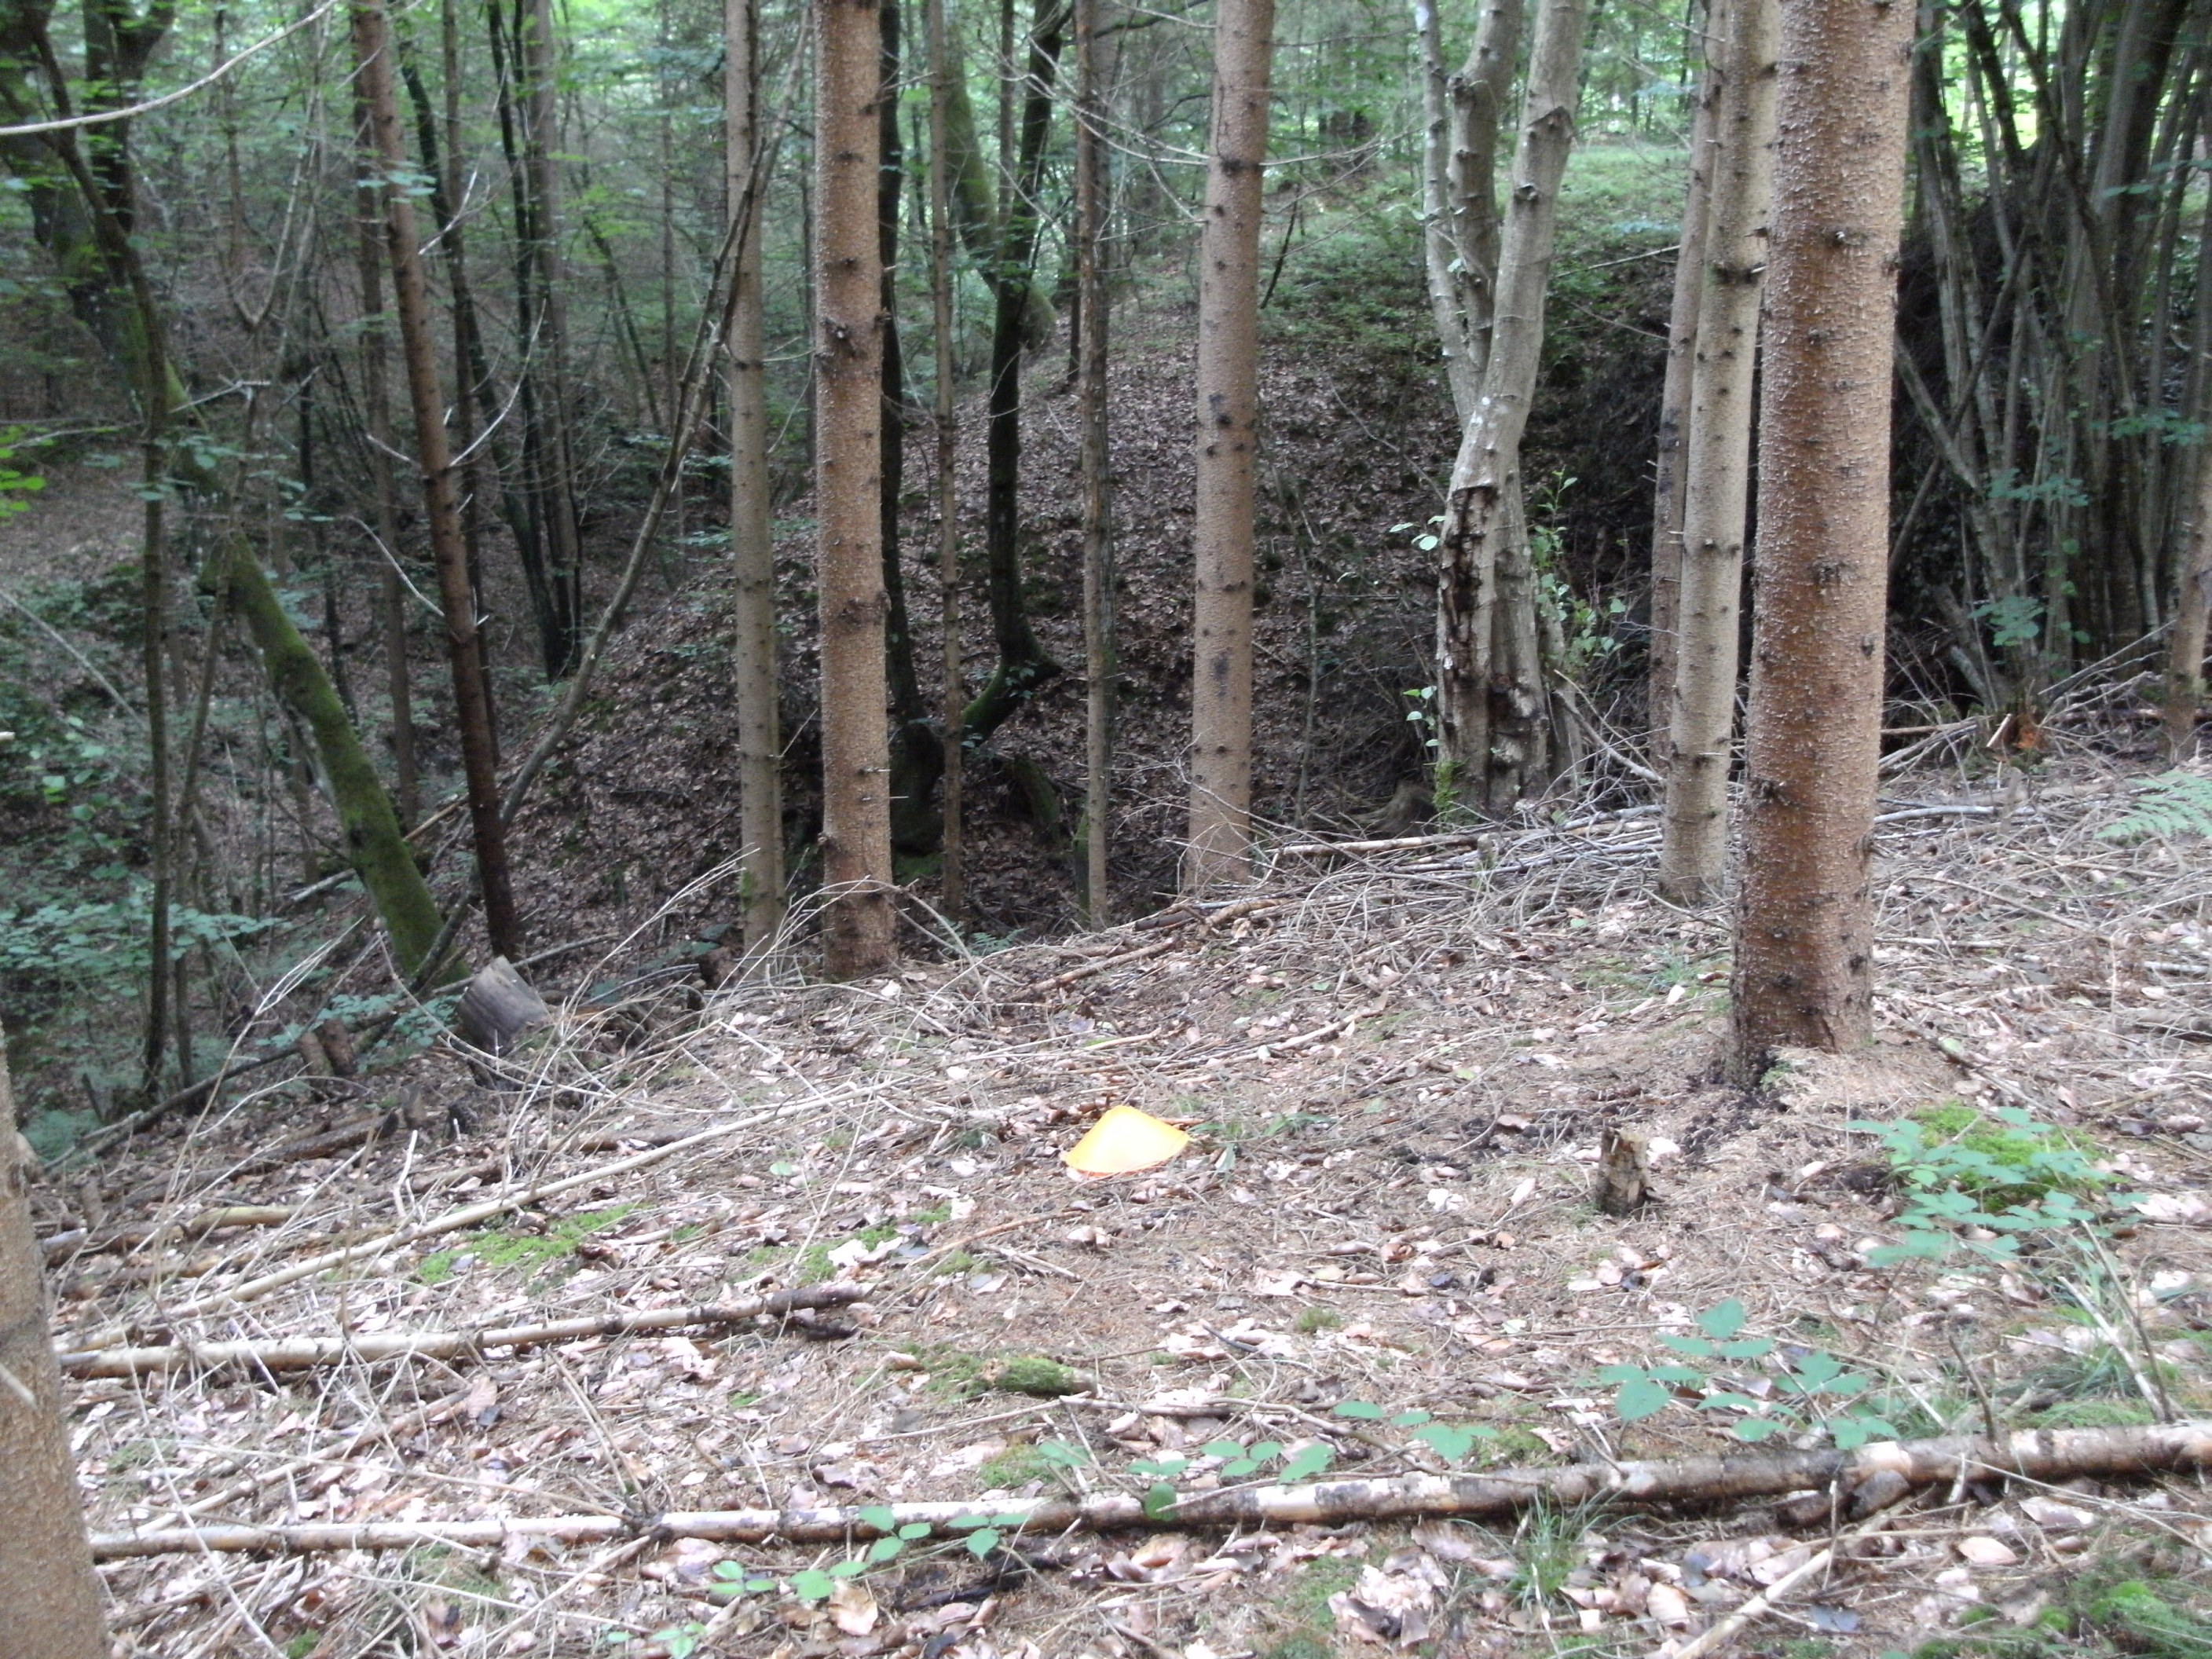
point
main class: Woodland
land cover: Spruce dominated coniferous woodland
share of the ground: > 75 %
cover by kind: coniferous forest trees 80 %, broadleaved forest trees 10 %, unconsolidated bare surface 10 %
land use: Forestry
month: July
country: AT
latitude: 46.5959
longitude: 14.5793
